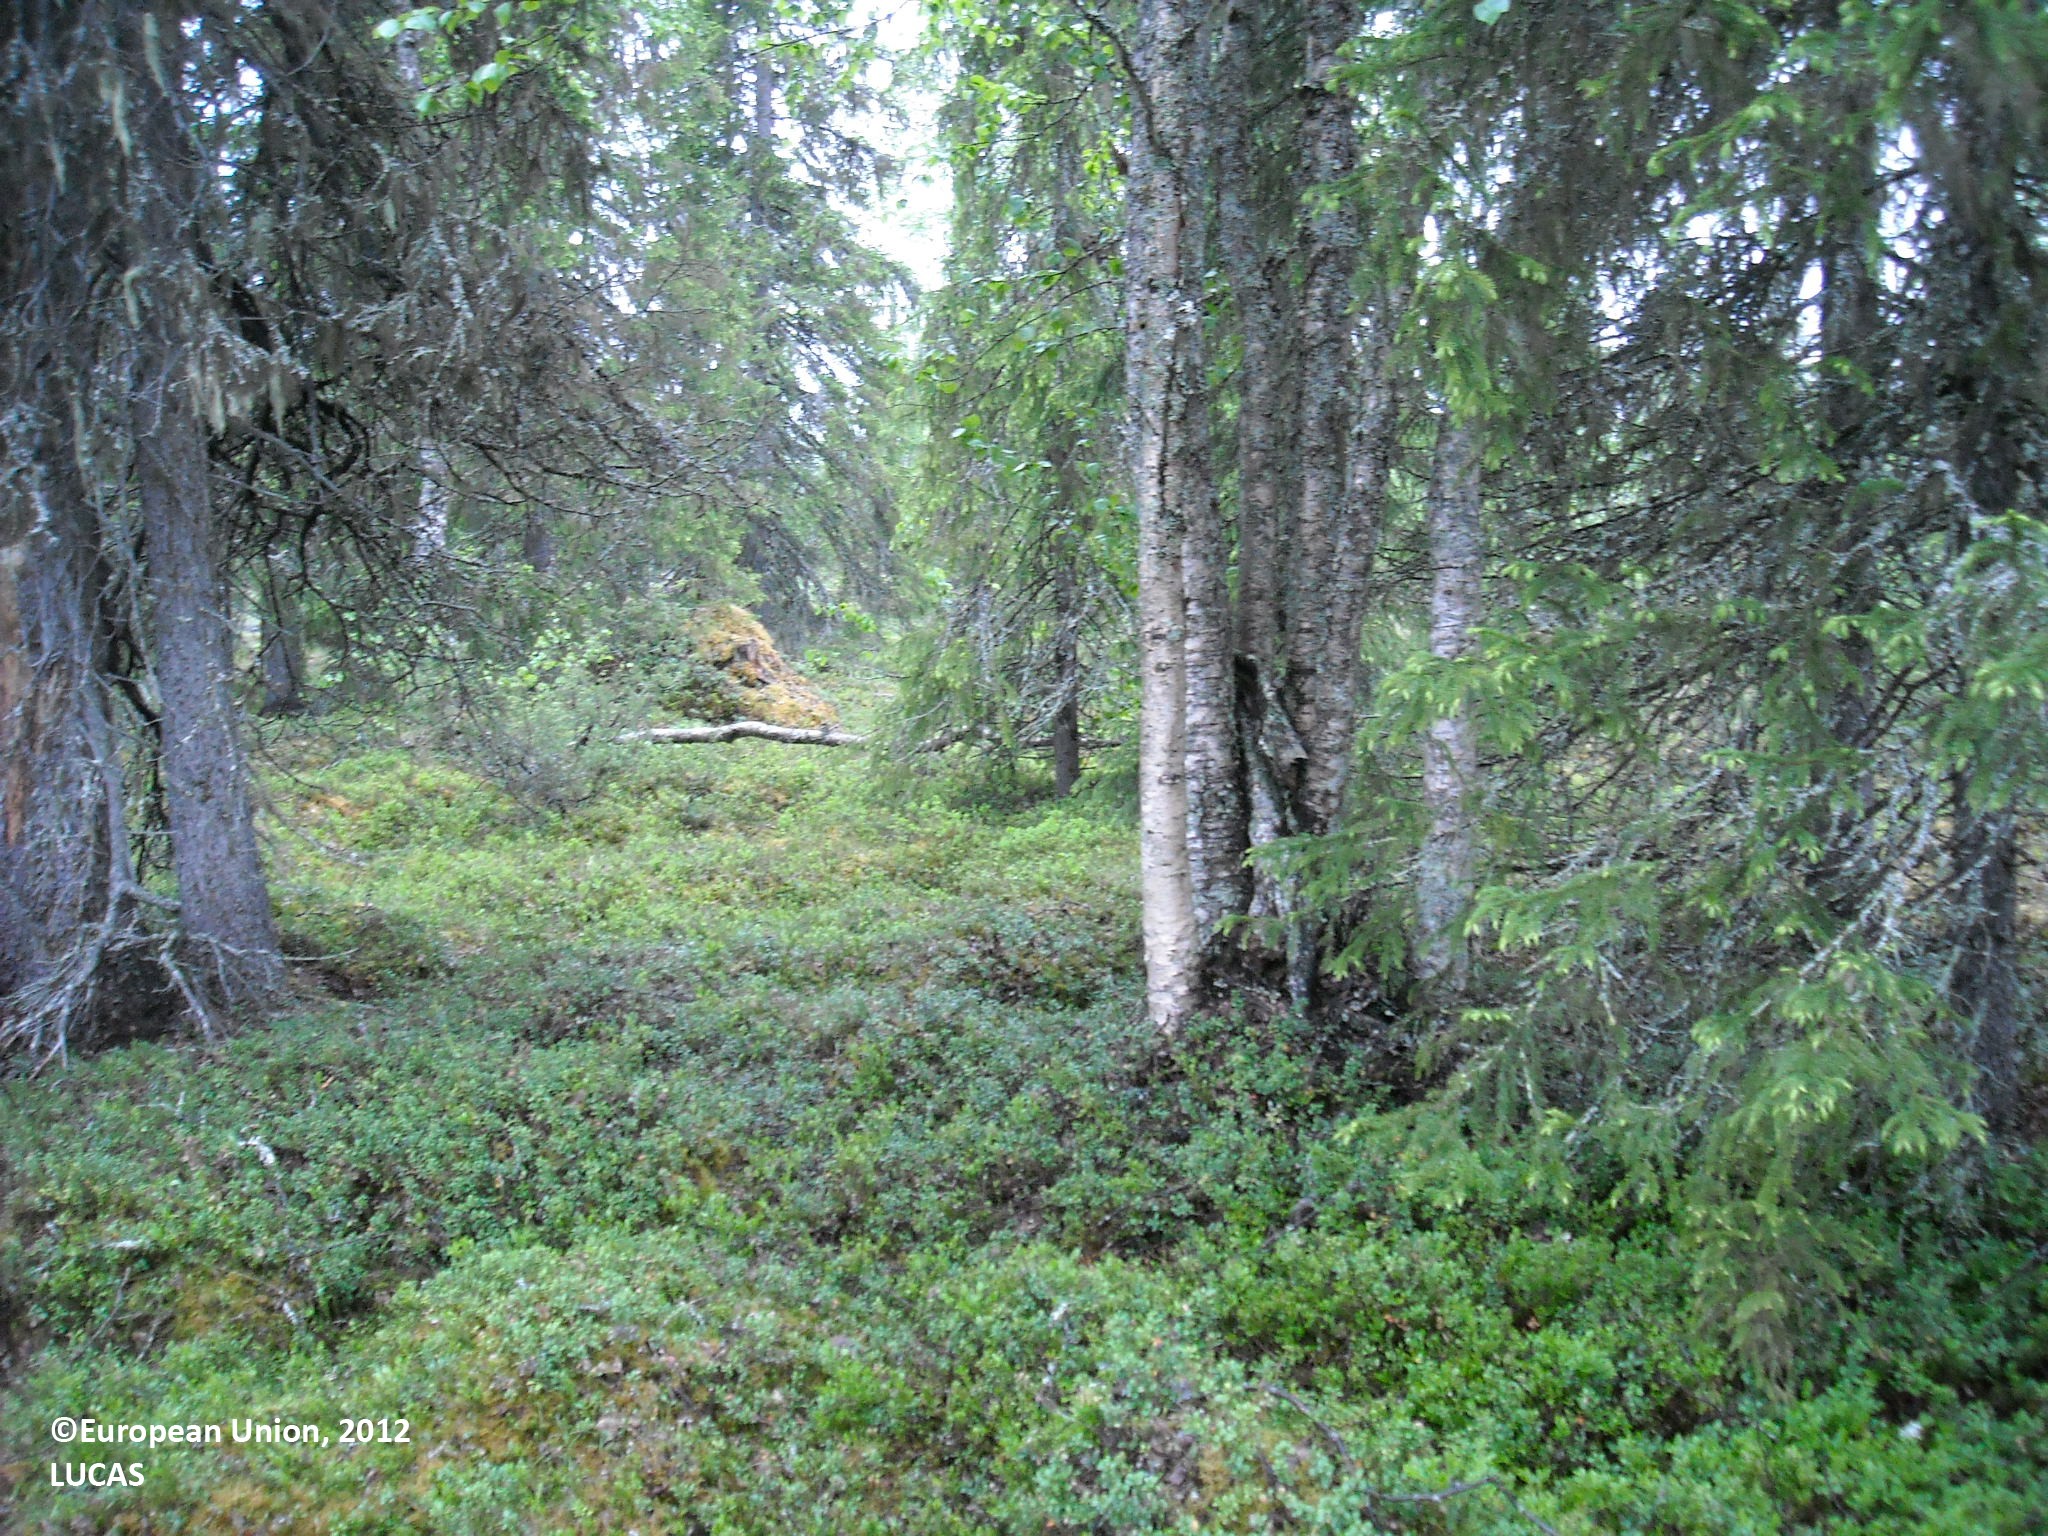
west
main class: Woodland
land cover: Spruce dominated mixed woodland
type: mire and swamp forests
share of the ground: 50 - 75 %
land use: Forestry
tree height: > 5 m
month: June
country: FI
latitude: 65.6290
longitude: 28.0178
